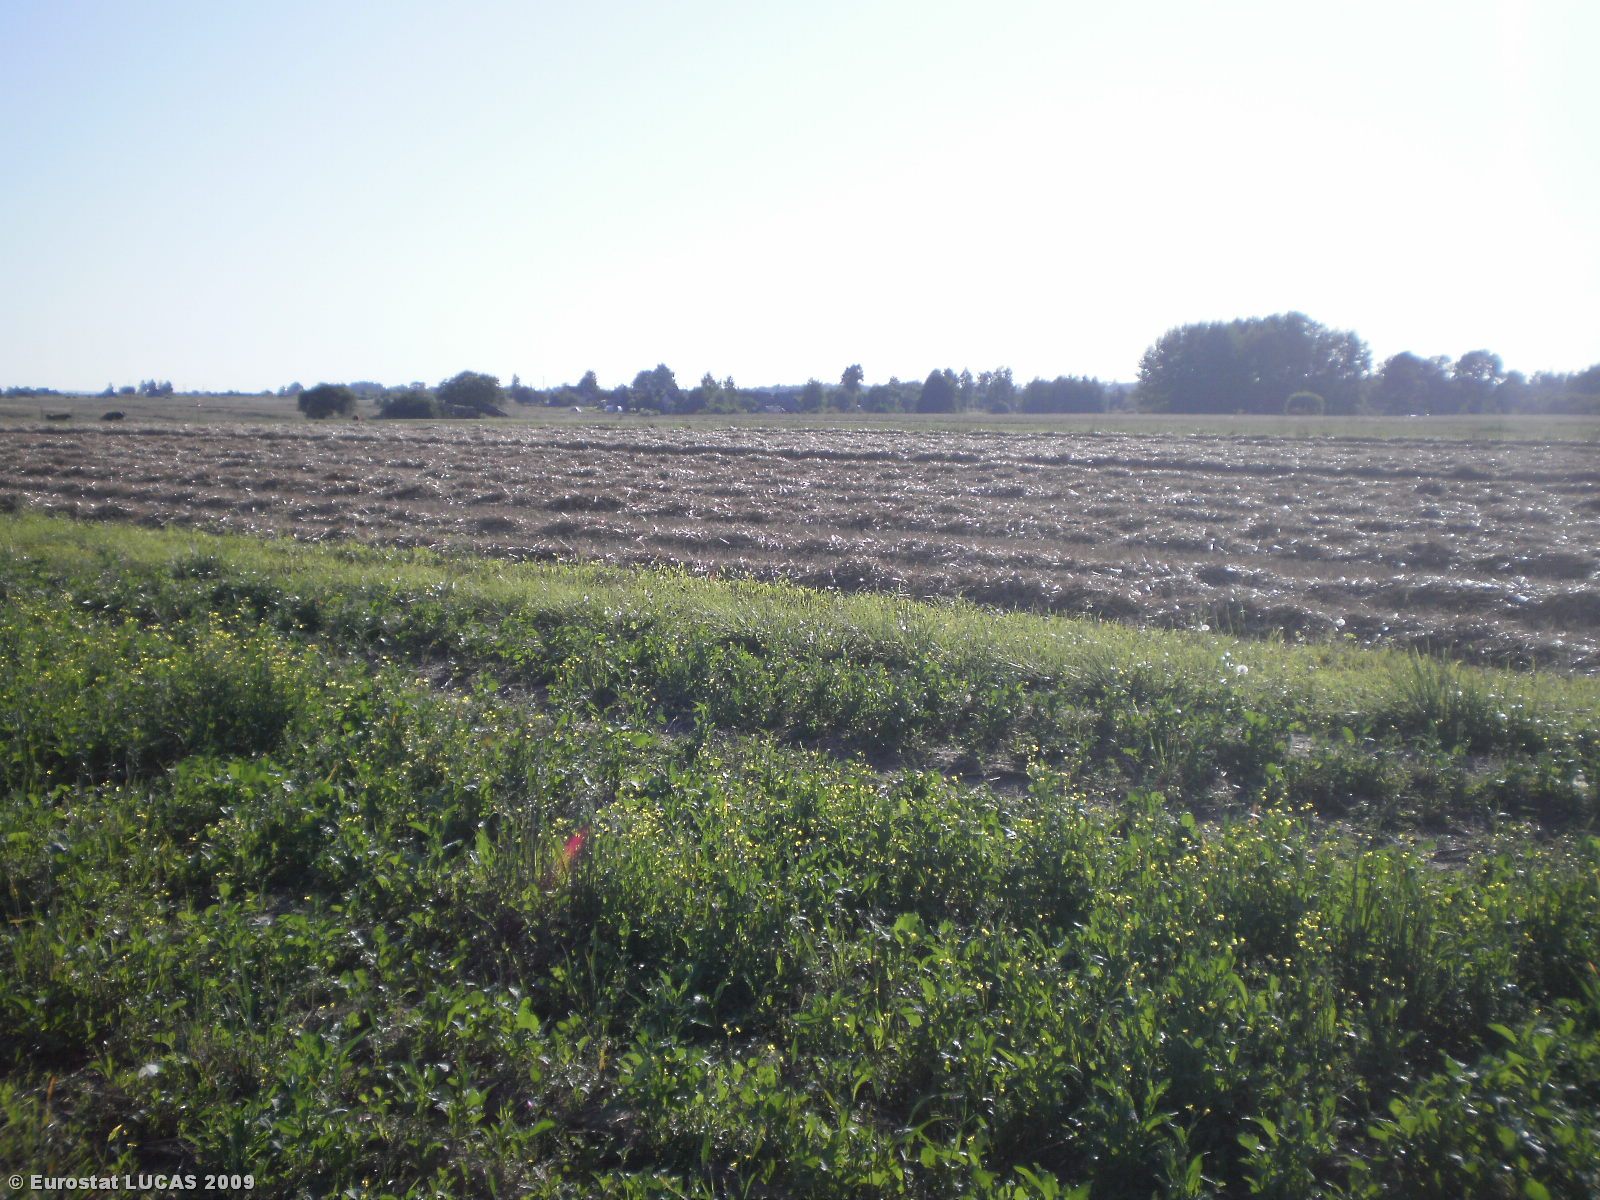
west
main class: Grassland
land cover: Spontaneously vegetated surfaces
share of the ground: > 75 %
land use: Fallow land
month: August
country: LT
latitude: 54.8369
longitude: 24.7275
